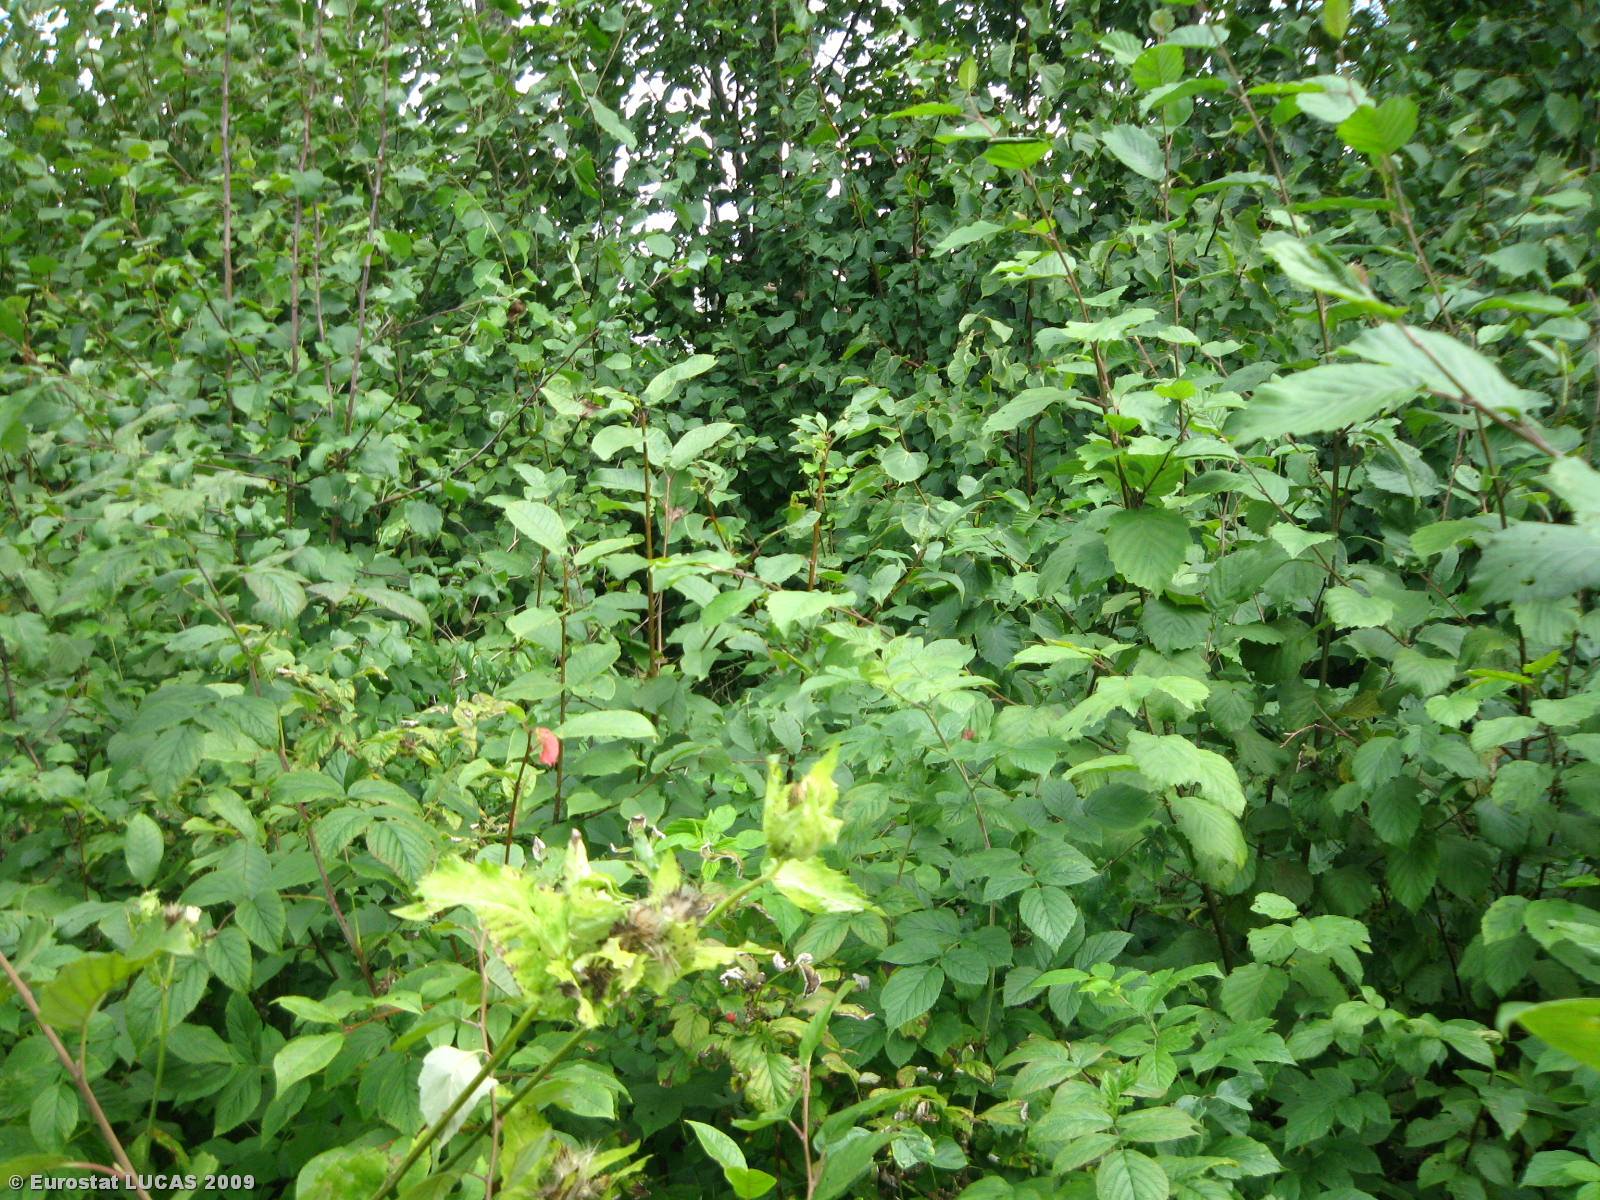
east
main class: Woodland
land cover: Broadleaved woodland
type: mesophytic deciduous forest
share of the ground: > 75 %
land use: Forestry
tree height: > 5 m
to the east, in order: Broadleaved woodland
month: August
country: LT
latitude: 56.2402
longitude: 24.1429
